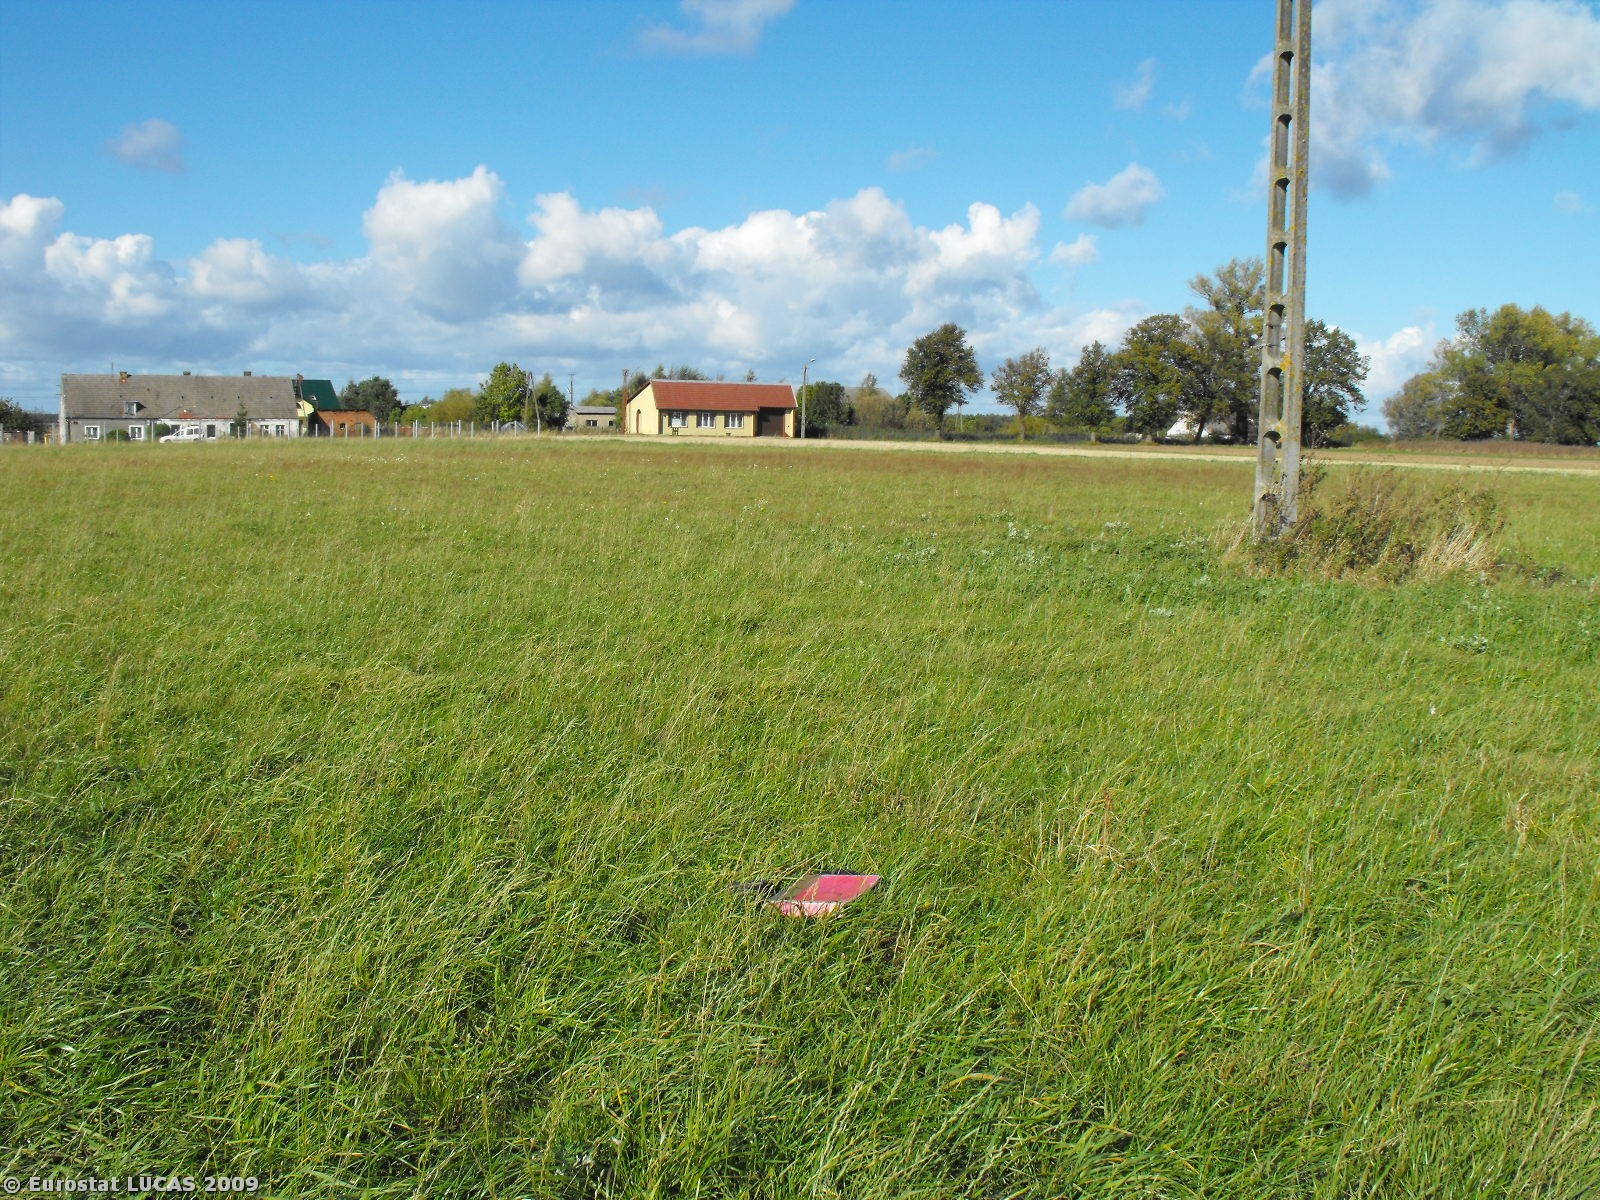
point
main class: Grassland
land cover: Grassland without tree/shrub cover
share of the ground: > 75 %
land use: Agriculture (excluding fallow land and kitchen gardens)
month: September
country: PL
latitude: 54.1281
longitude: 15.4044
